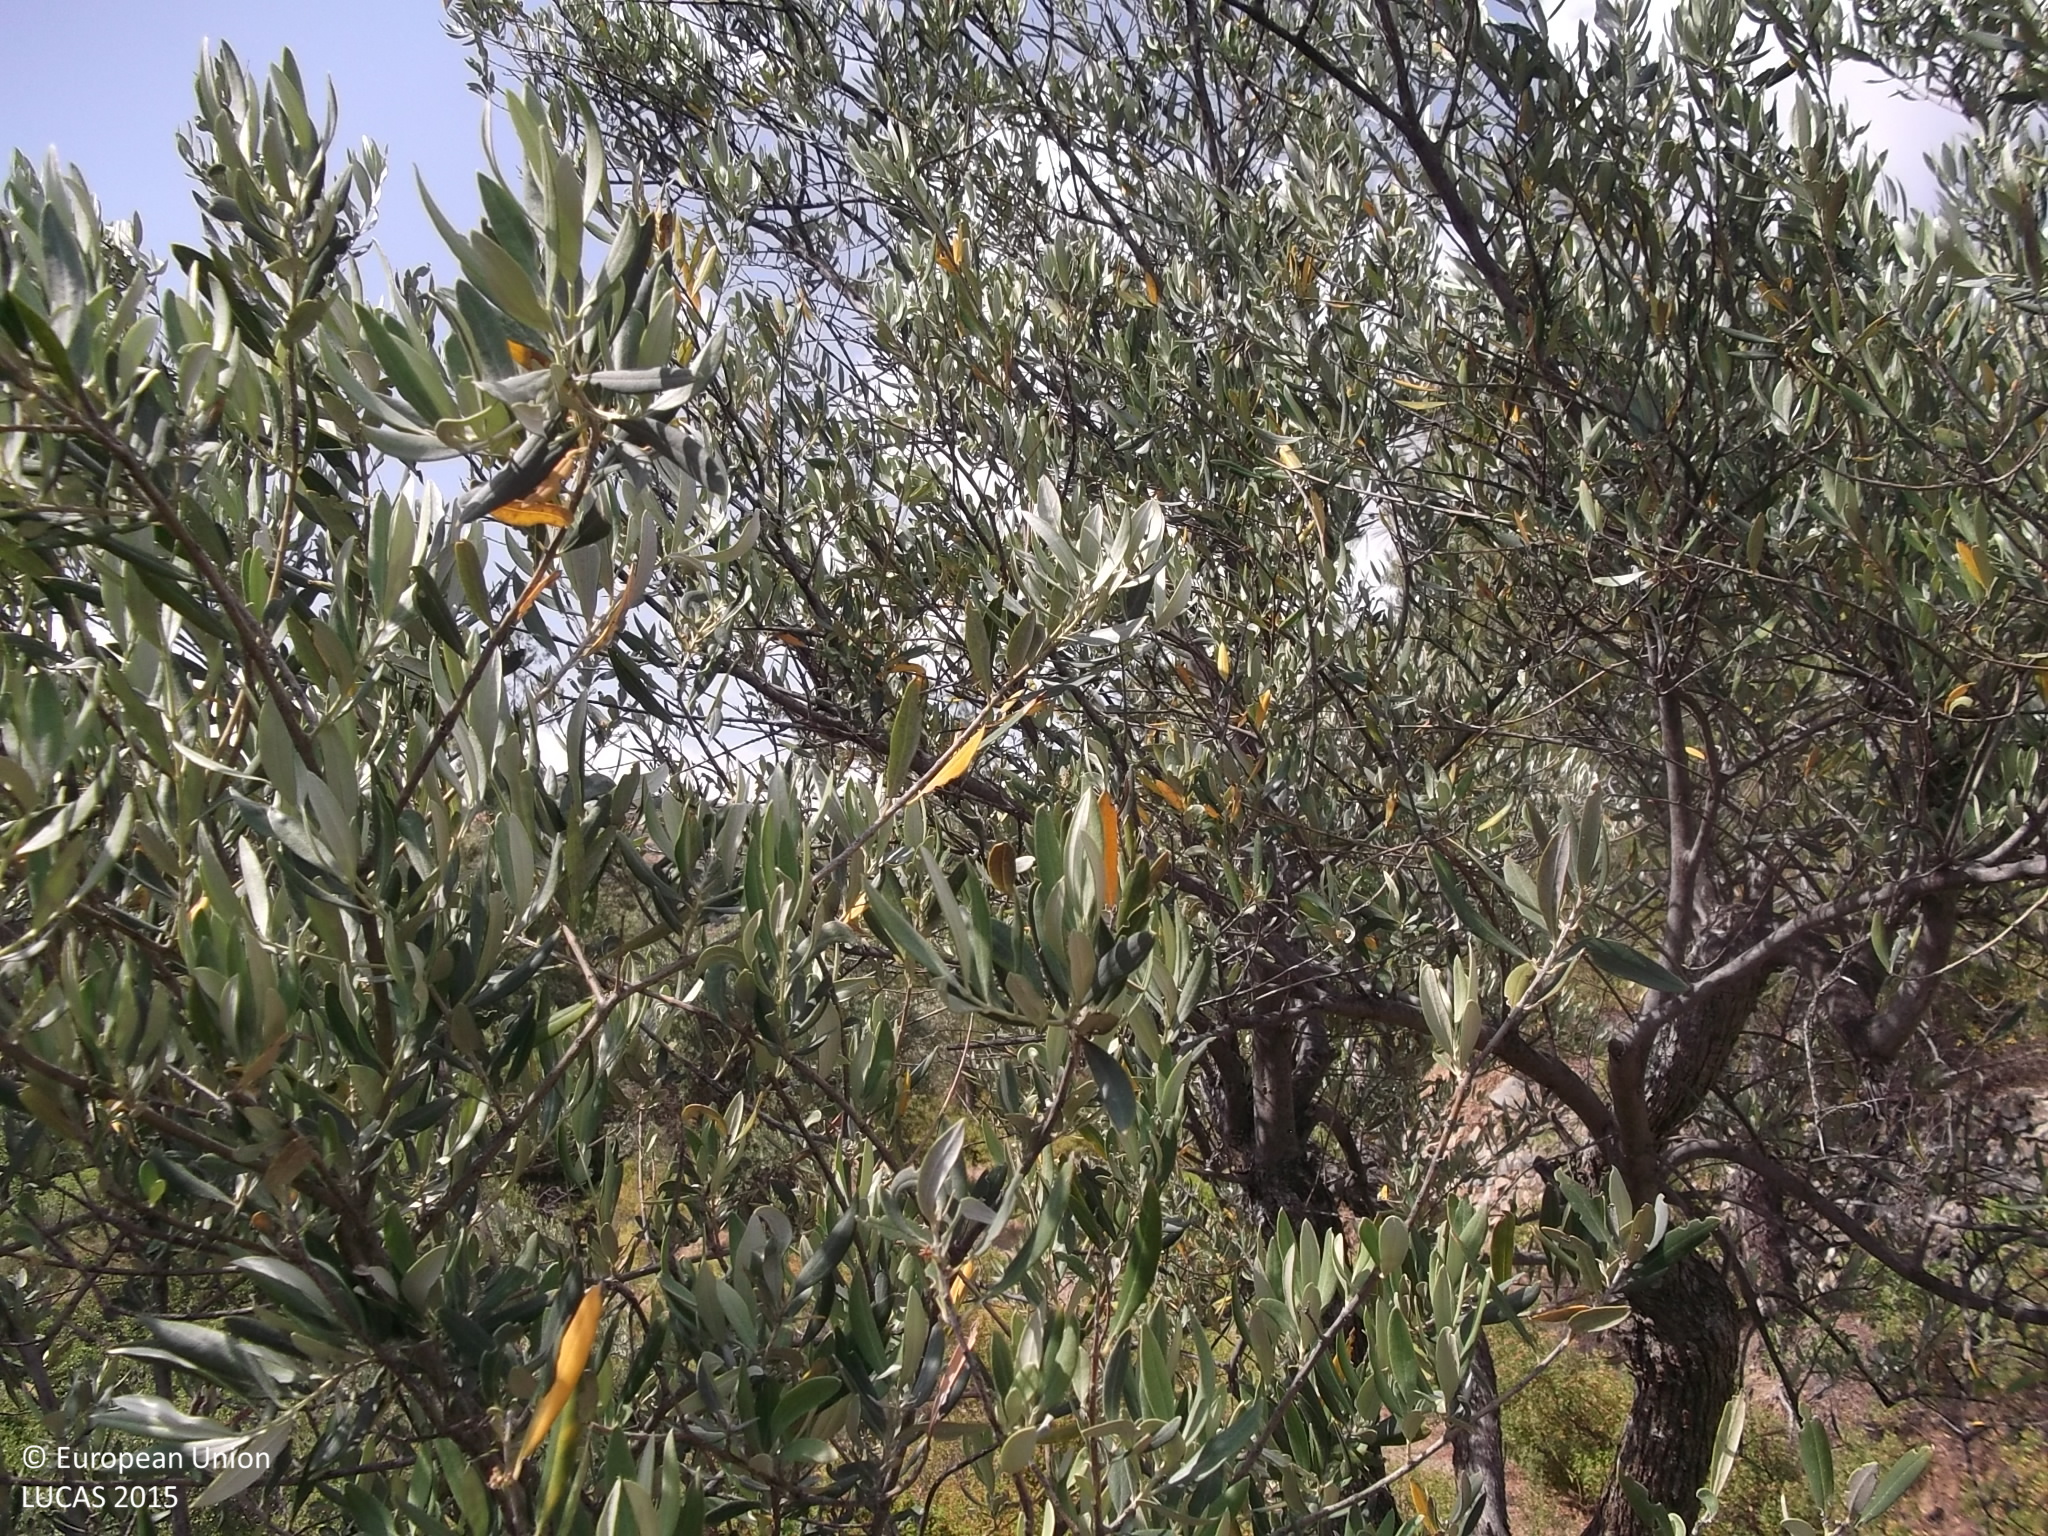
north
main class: Woodland
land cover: Pine dominated coniferous woodland
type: coniferous forest of the mediterranean region
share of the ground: 25 - 50 %
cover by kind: shrubs 45 %, coniferous forest trees 25 %, consolidated bare surface 15 %, unconsolidated bare surface 15 %
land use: Forestry
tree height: > 5 m
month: June
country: CY
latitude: 34.8744
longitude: 32.9789
